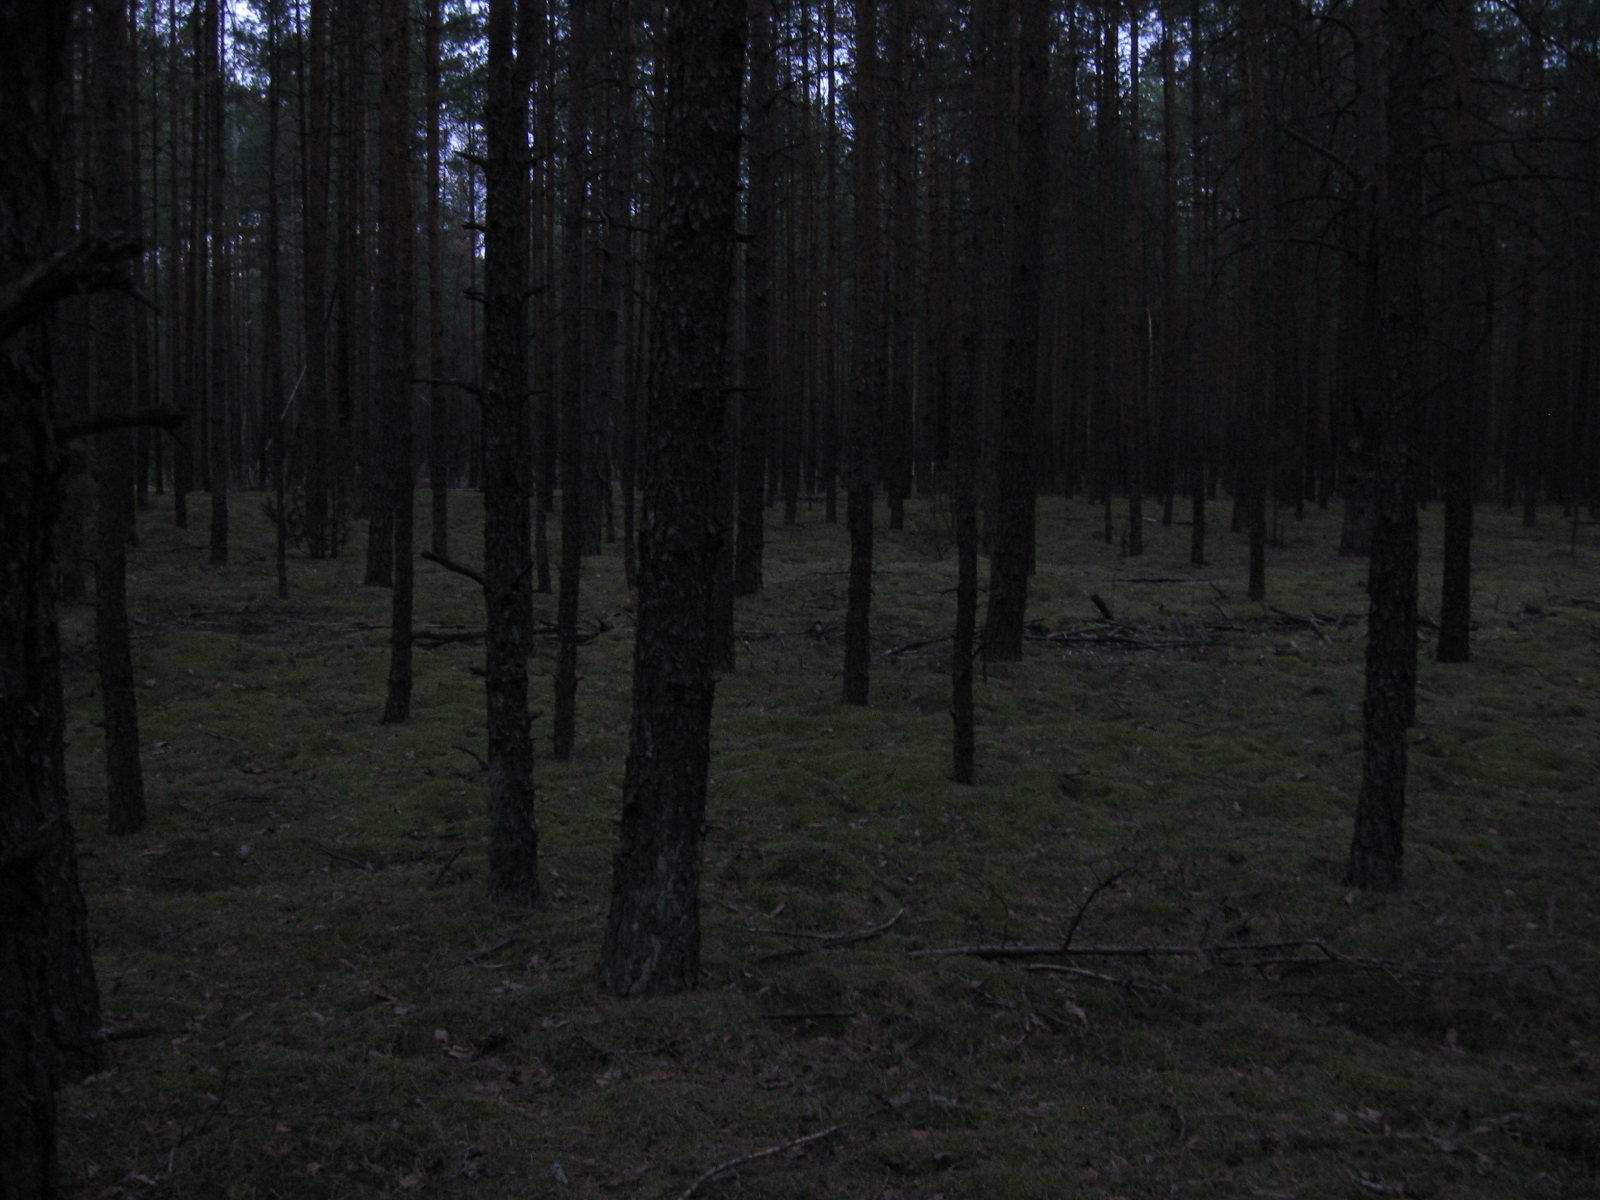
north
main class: Woodland
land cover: Pine dominated coniferous woodland
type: hemiboreal forest and nemoral coniferous forest and mixed broadleaved-coniferous forest
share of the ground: > 75 %
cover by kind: coniferous forest trees 90 %, lichens and mosses 10 %
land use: Forestry
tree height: > 5 m
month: June
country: LT
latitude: 54.1283
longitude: 24.2220
